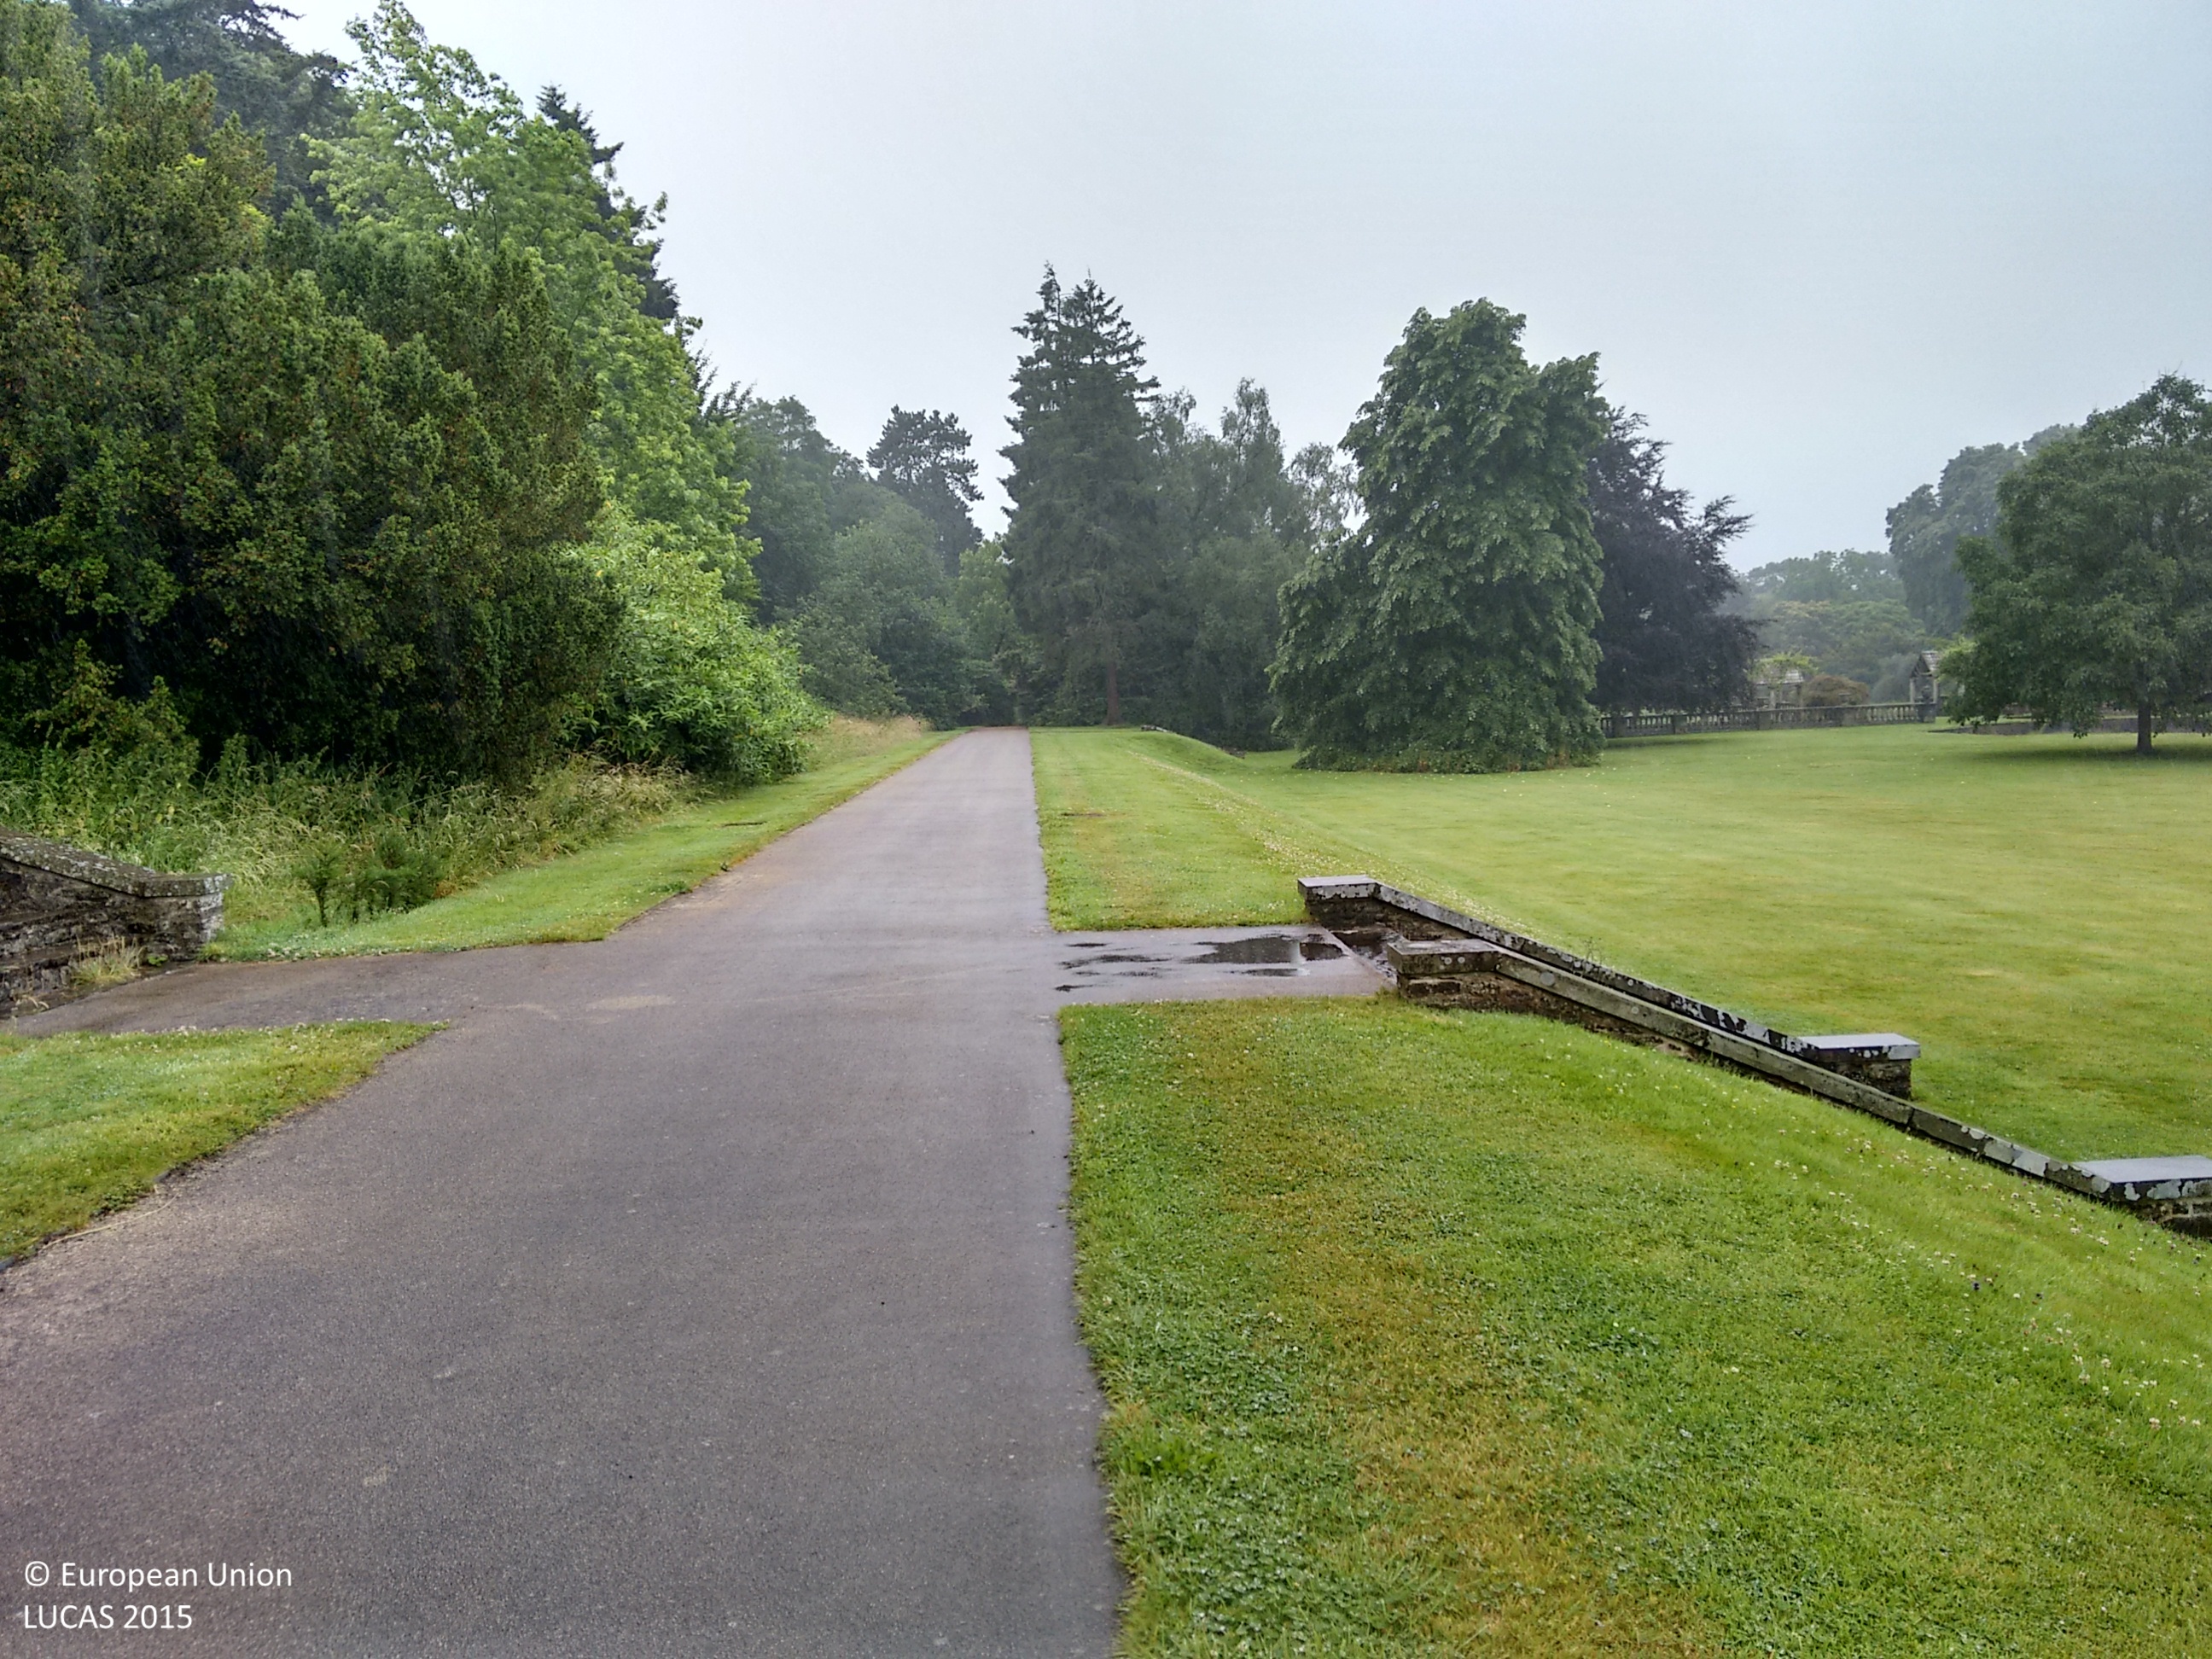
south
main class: Grassland
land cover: Grassland without tree/shrub cover
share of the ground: > 75 %
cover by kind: herbaceous plants 100 %
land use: Amenities, museums, leisure
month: July
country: GB
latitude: 51.4421
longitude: -3.3025
